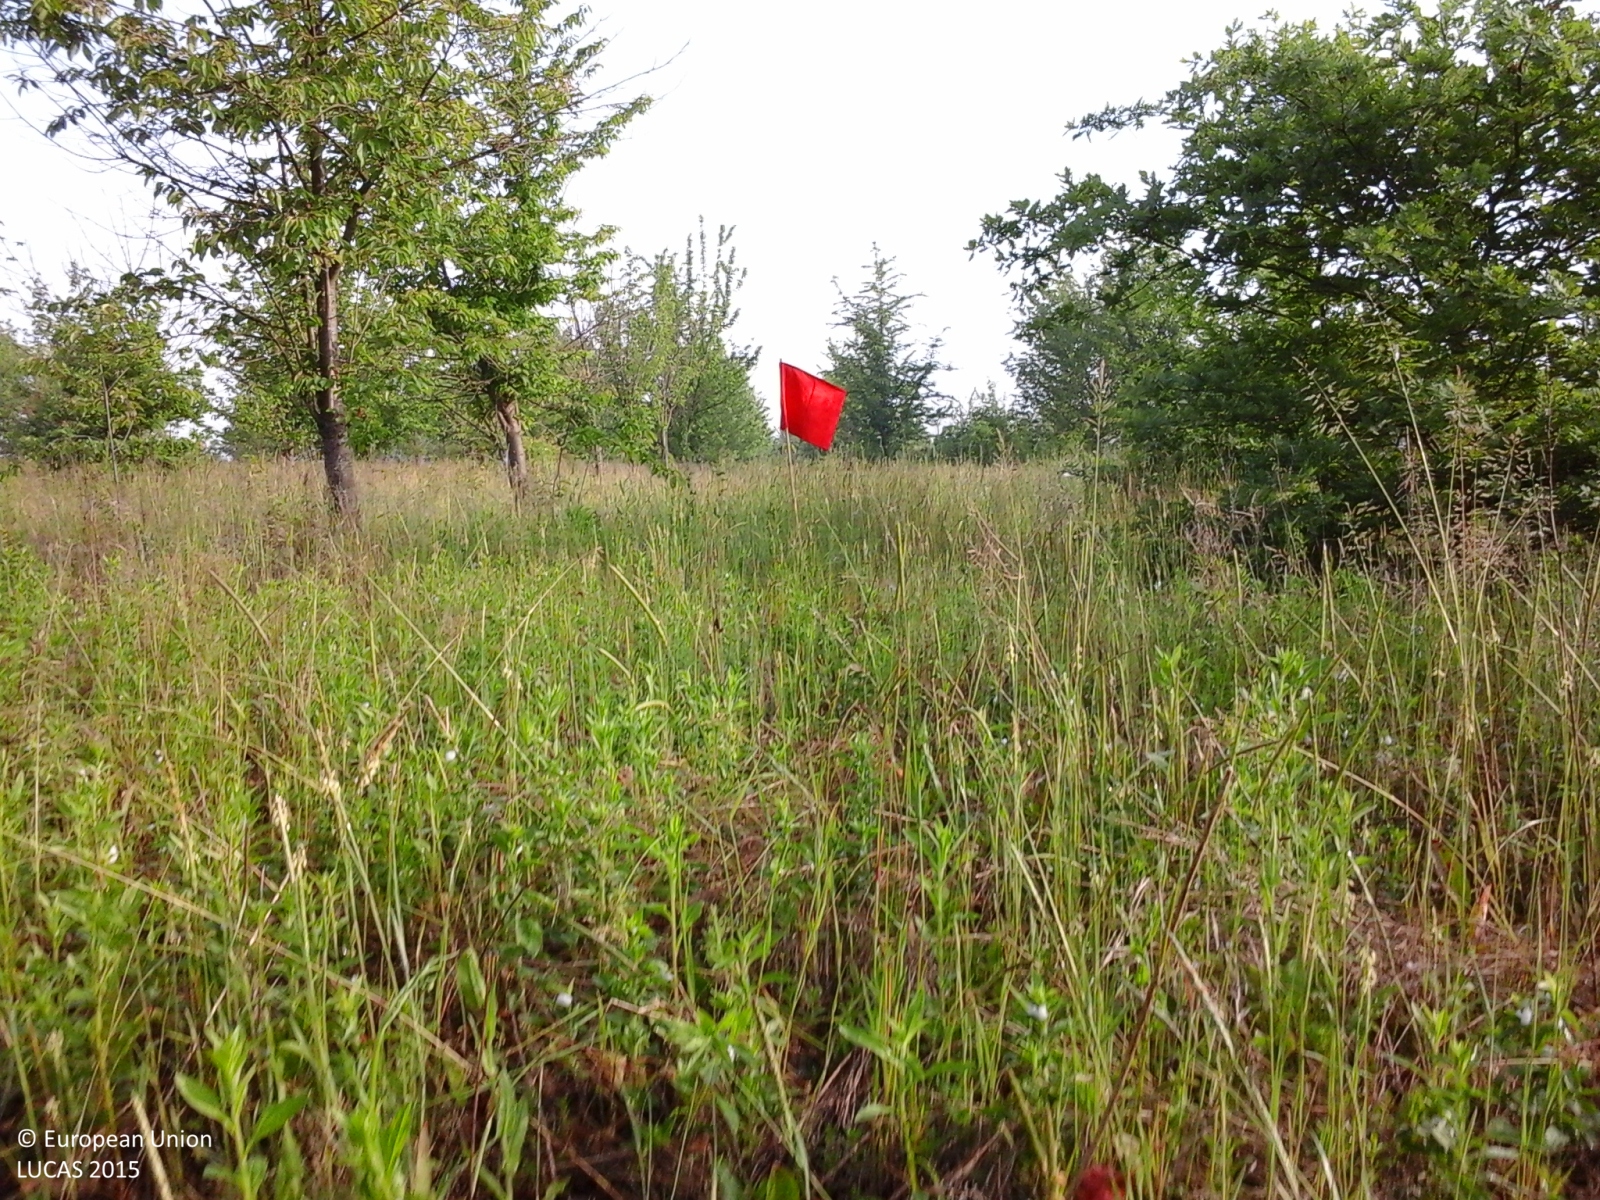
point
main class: Cropland
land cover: Cherry fruit
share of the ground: 10 - 25 %
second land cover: Spontaneously vegetated surfaces
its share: > 75 %
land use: Abandoned areas
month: May
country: IT
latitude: 44.9341
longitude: 8.4444
